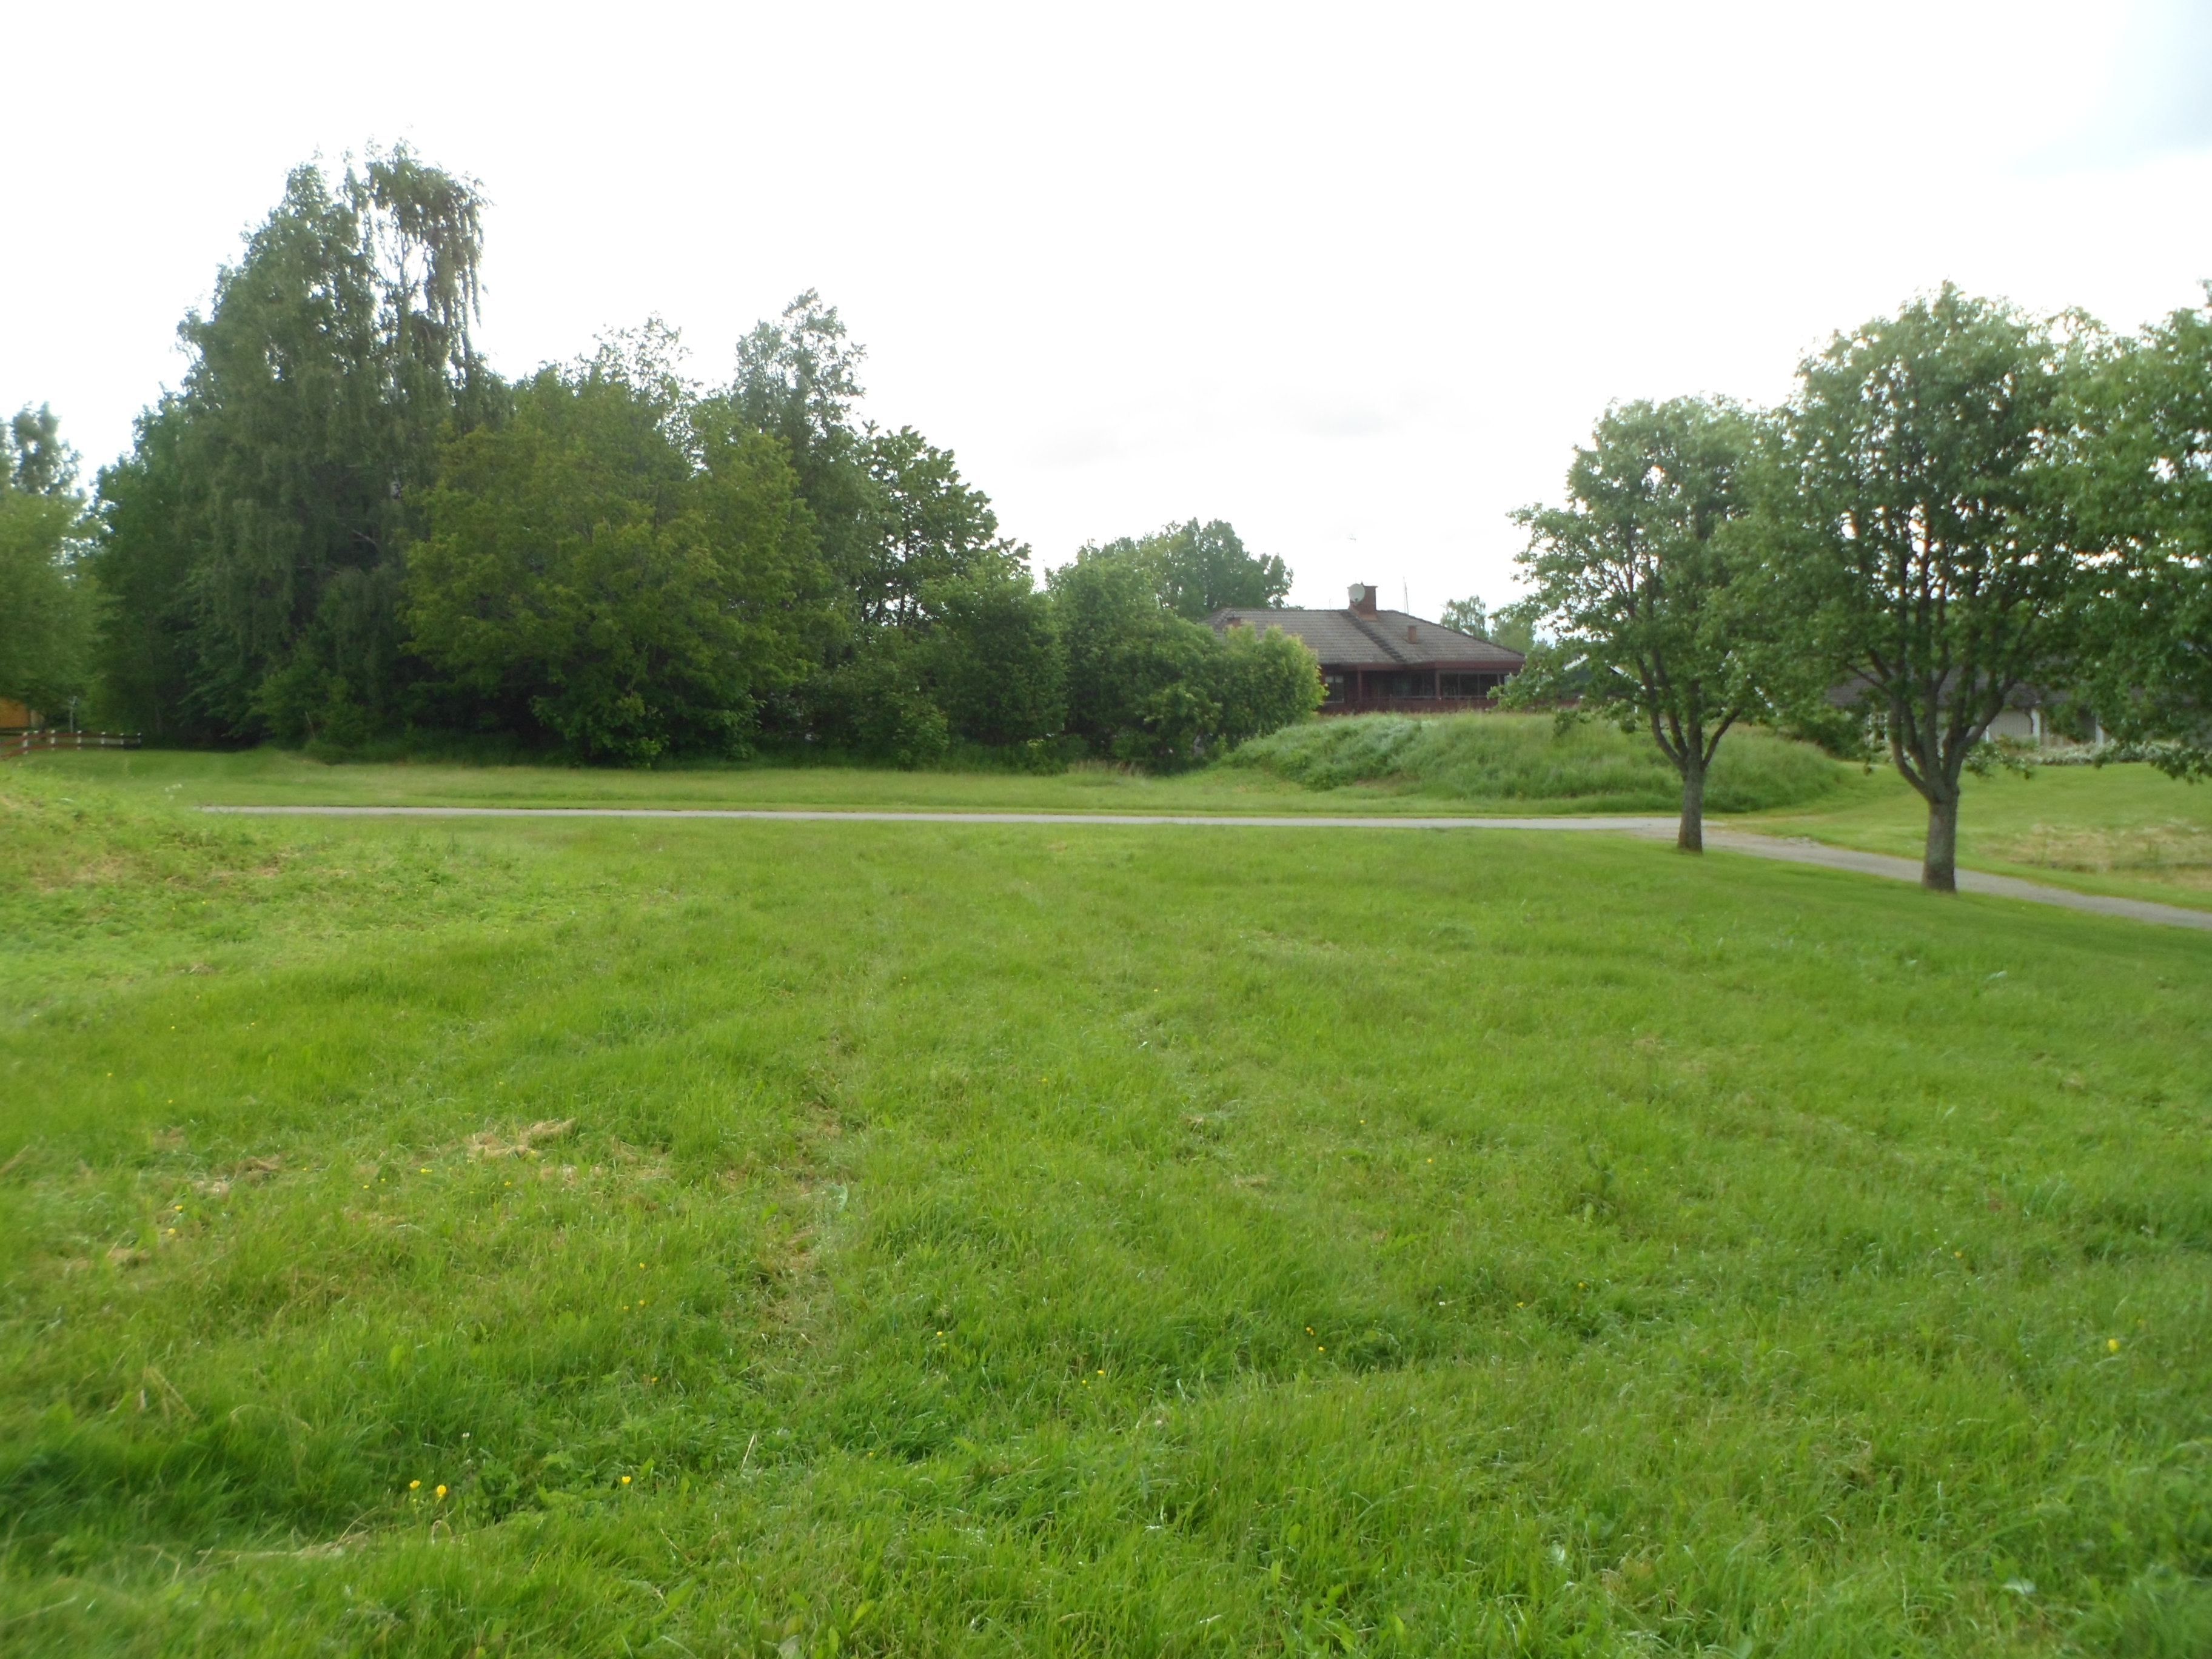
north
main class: Grassland
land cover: Grassland without tree/shrub cover
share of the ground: > 75 %
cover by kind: herbaceous plants 100 %
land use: Community services
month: June
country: SE
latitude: 56.8986
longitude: 14.5775
